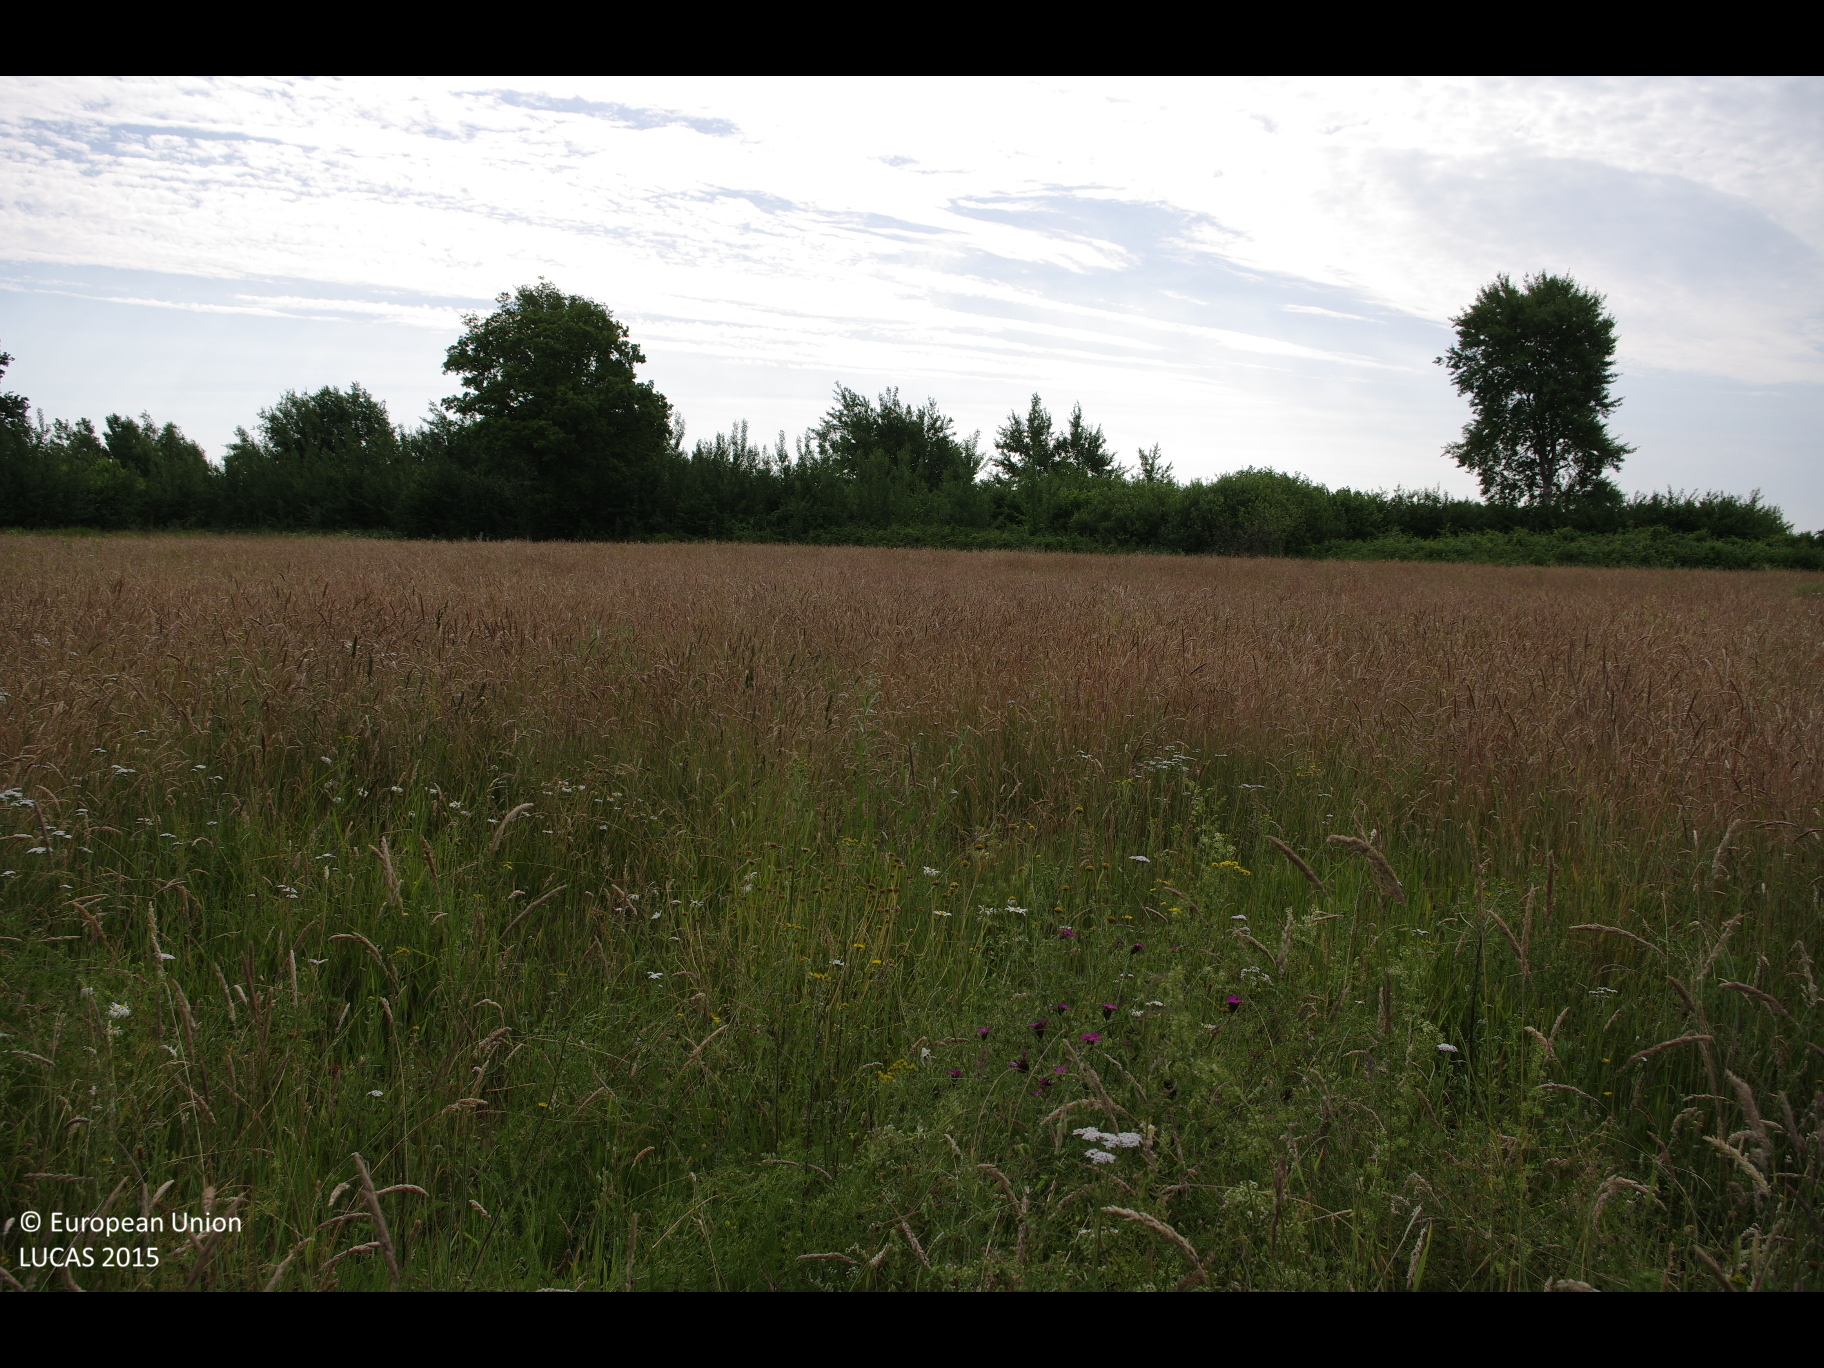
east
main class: Grassland
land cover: Grassland without tree/shrub cover
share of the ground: > 75 %
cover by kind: herbaceous plants 100 %
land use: Agriculture (excluding fallow land and kitchen gardens)
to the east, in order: Grassland without tree/shrub cover; Fences; Abandoned hedges; Paved roads, cycling and walking lanes; Broadleaved woodland; Grassland without tree/shrub cover; Grassland with sparse tree/shrub cover; Fences; Grassland without tree/shrub cover
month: July
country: DE
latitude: 53.8317
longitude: 10.6226
